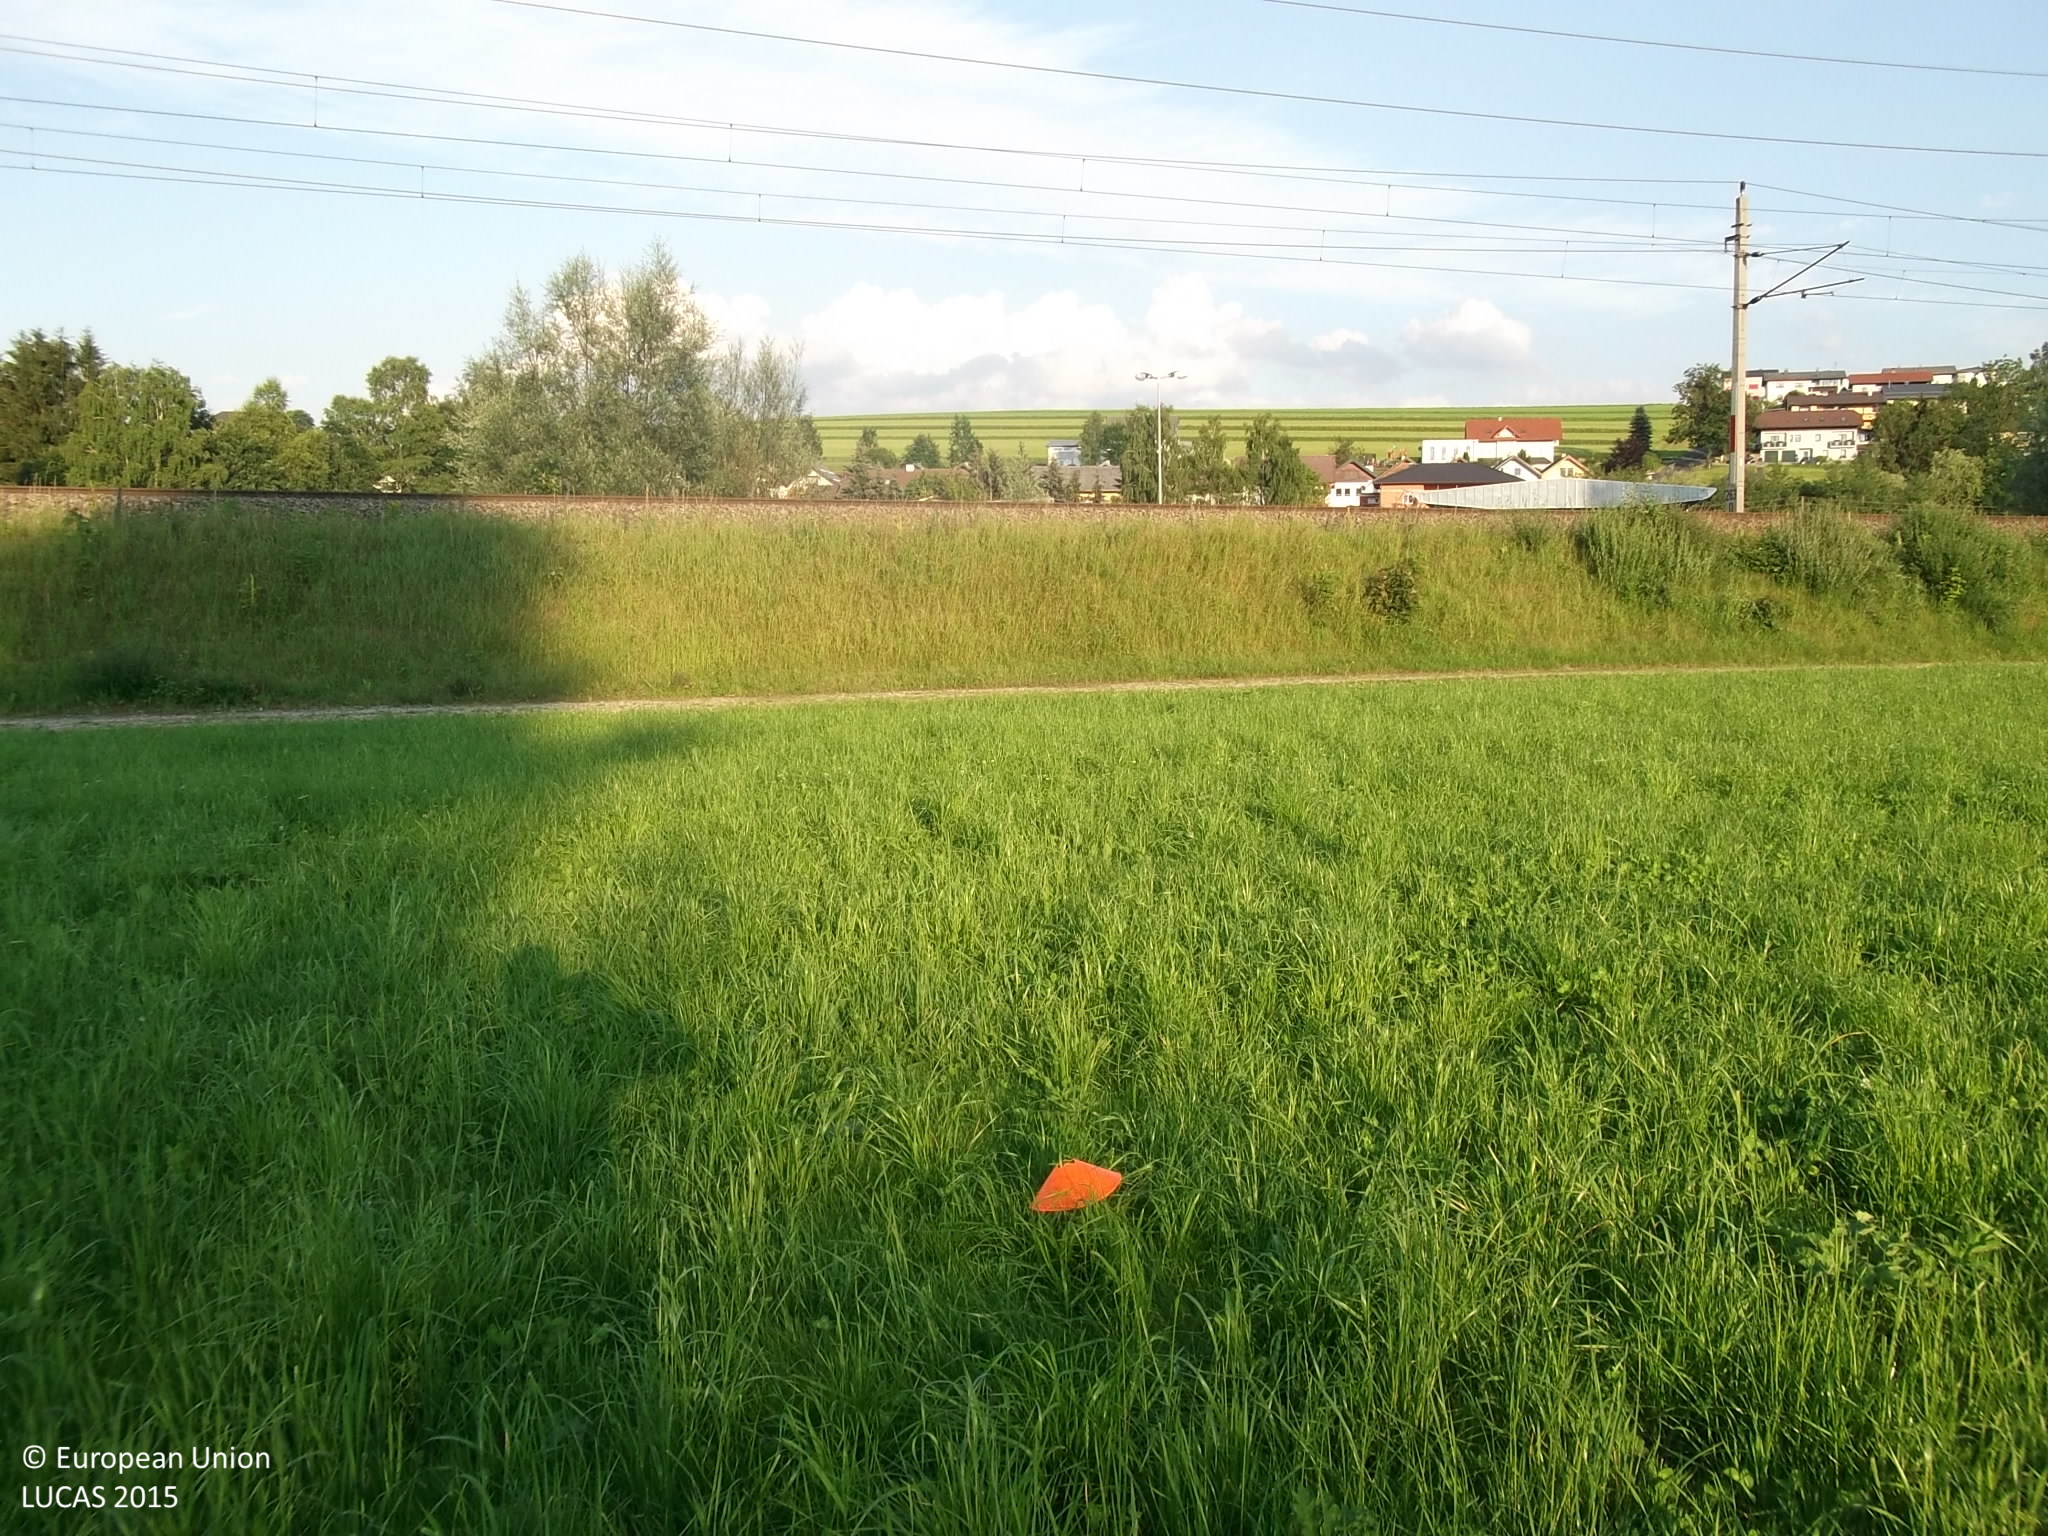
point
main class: Grassland
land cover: Grassland without tree/shrub cover
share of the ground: > 75 %
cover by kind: herbaceous plants 100 %
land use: Agriculture (excluding fallow land and kitchen gardens)
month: June
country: AT
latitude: 48.0060
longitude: 13.4975
